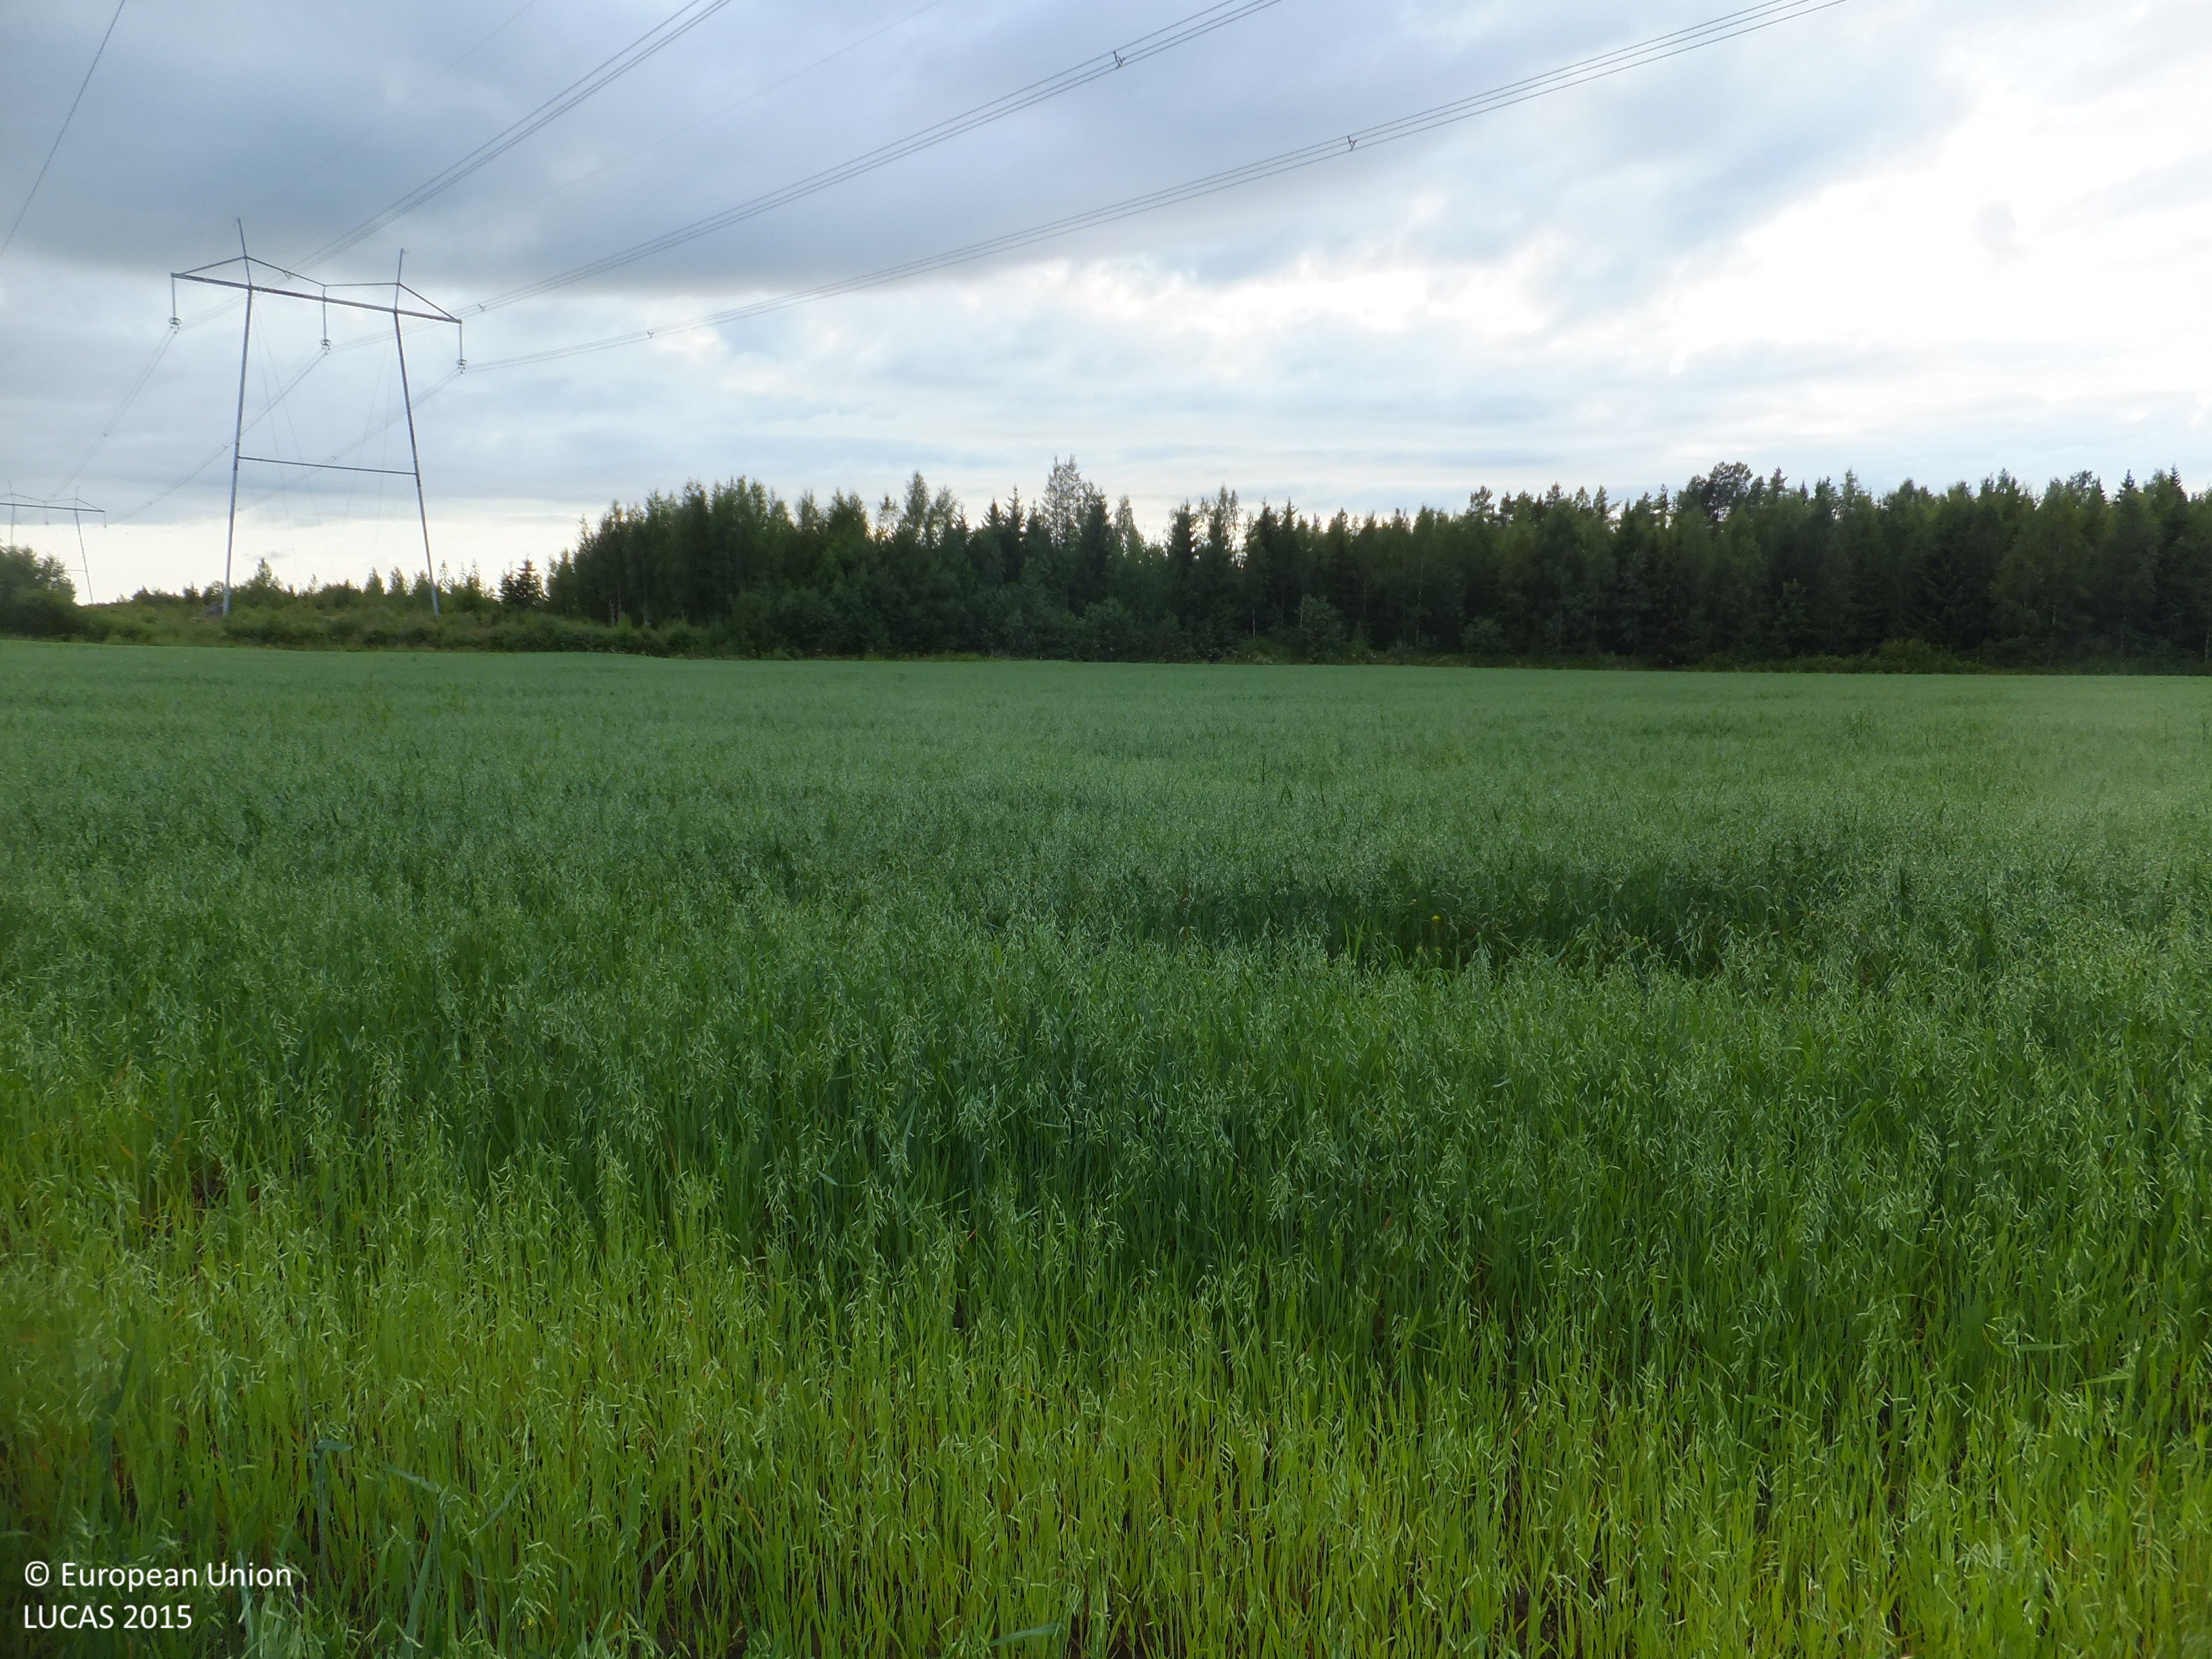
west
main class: Artificial land
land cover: Other artificial areas
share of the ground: > 75 %
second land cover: Oats
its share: > 75 %
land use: Electricity, gas and thermal power distribution
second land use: Agriculture (excluding fallow land and kitchen gardens)
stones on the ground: < 10 %
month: July
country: FI
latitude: 63.0709
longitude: 21.8986
